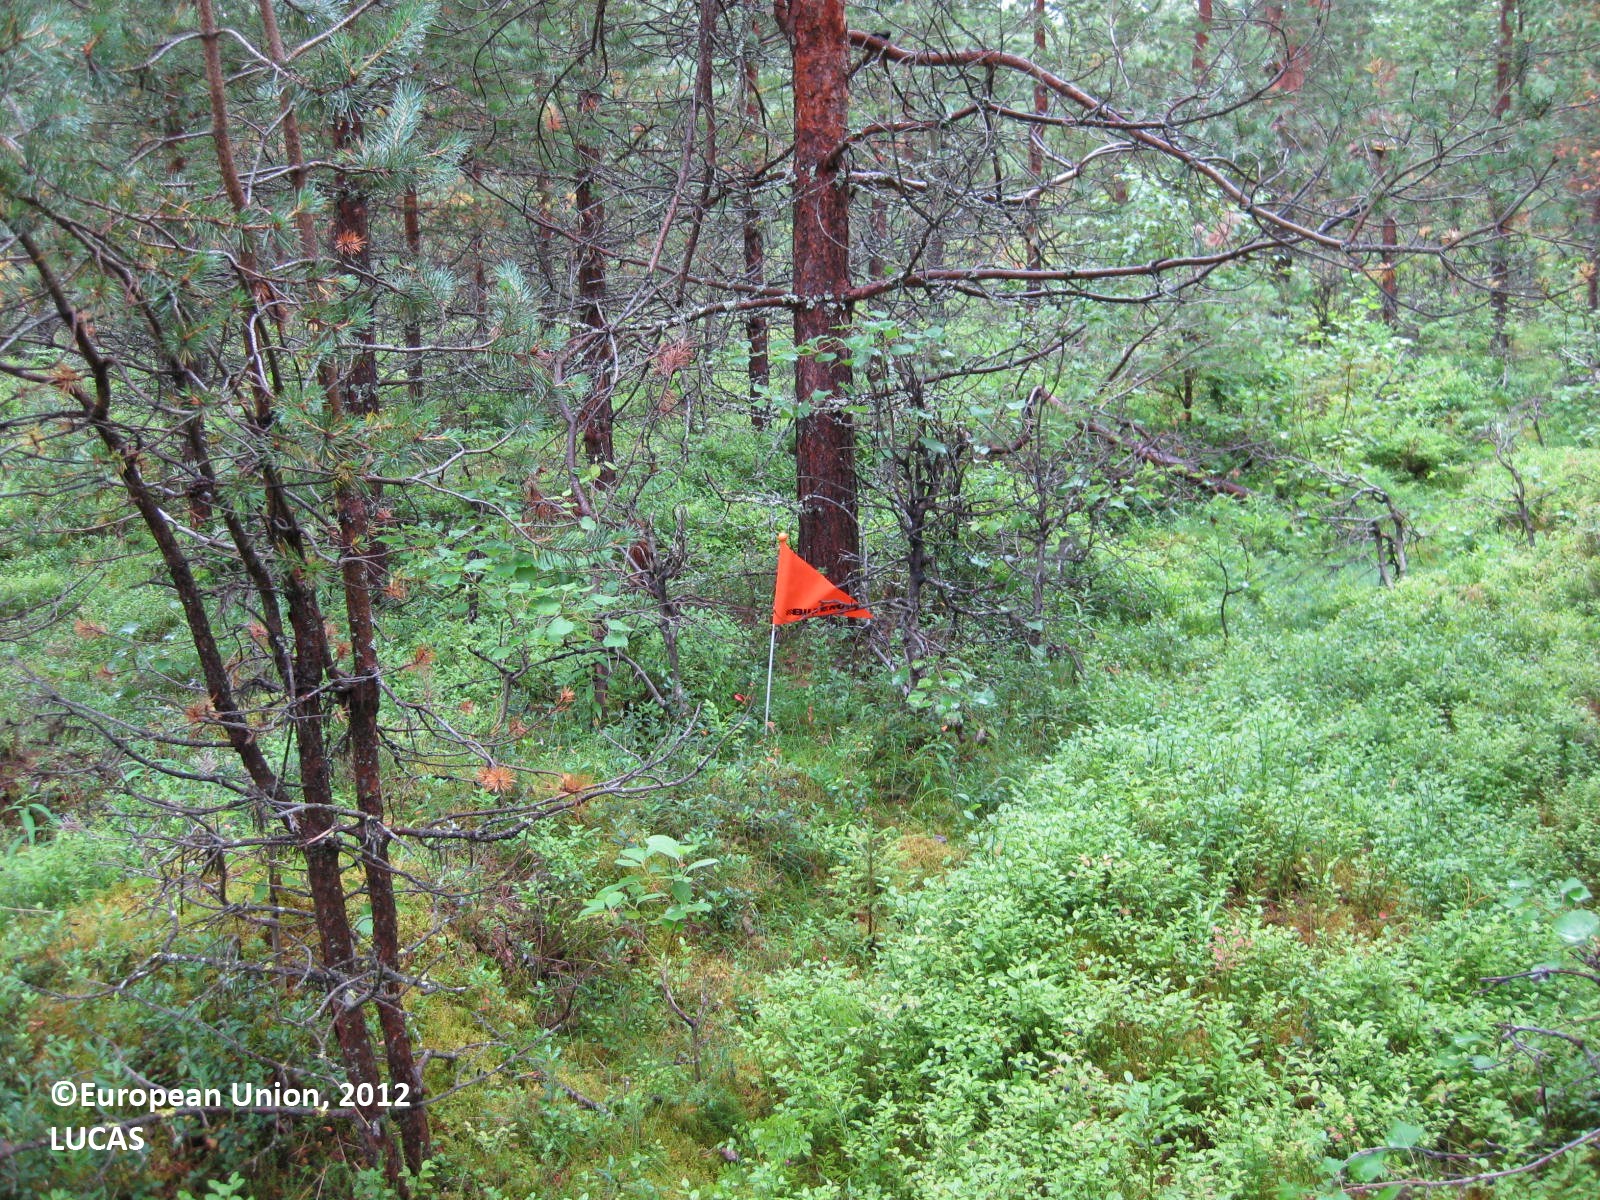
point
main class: Woodland
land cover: Pine dominated coniferous woodland
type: boreal forest
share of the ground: > 75 %
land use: Forestry
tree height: > 5 m
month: August
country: FI
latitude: 65.8719
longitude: 28.1884
